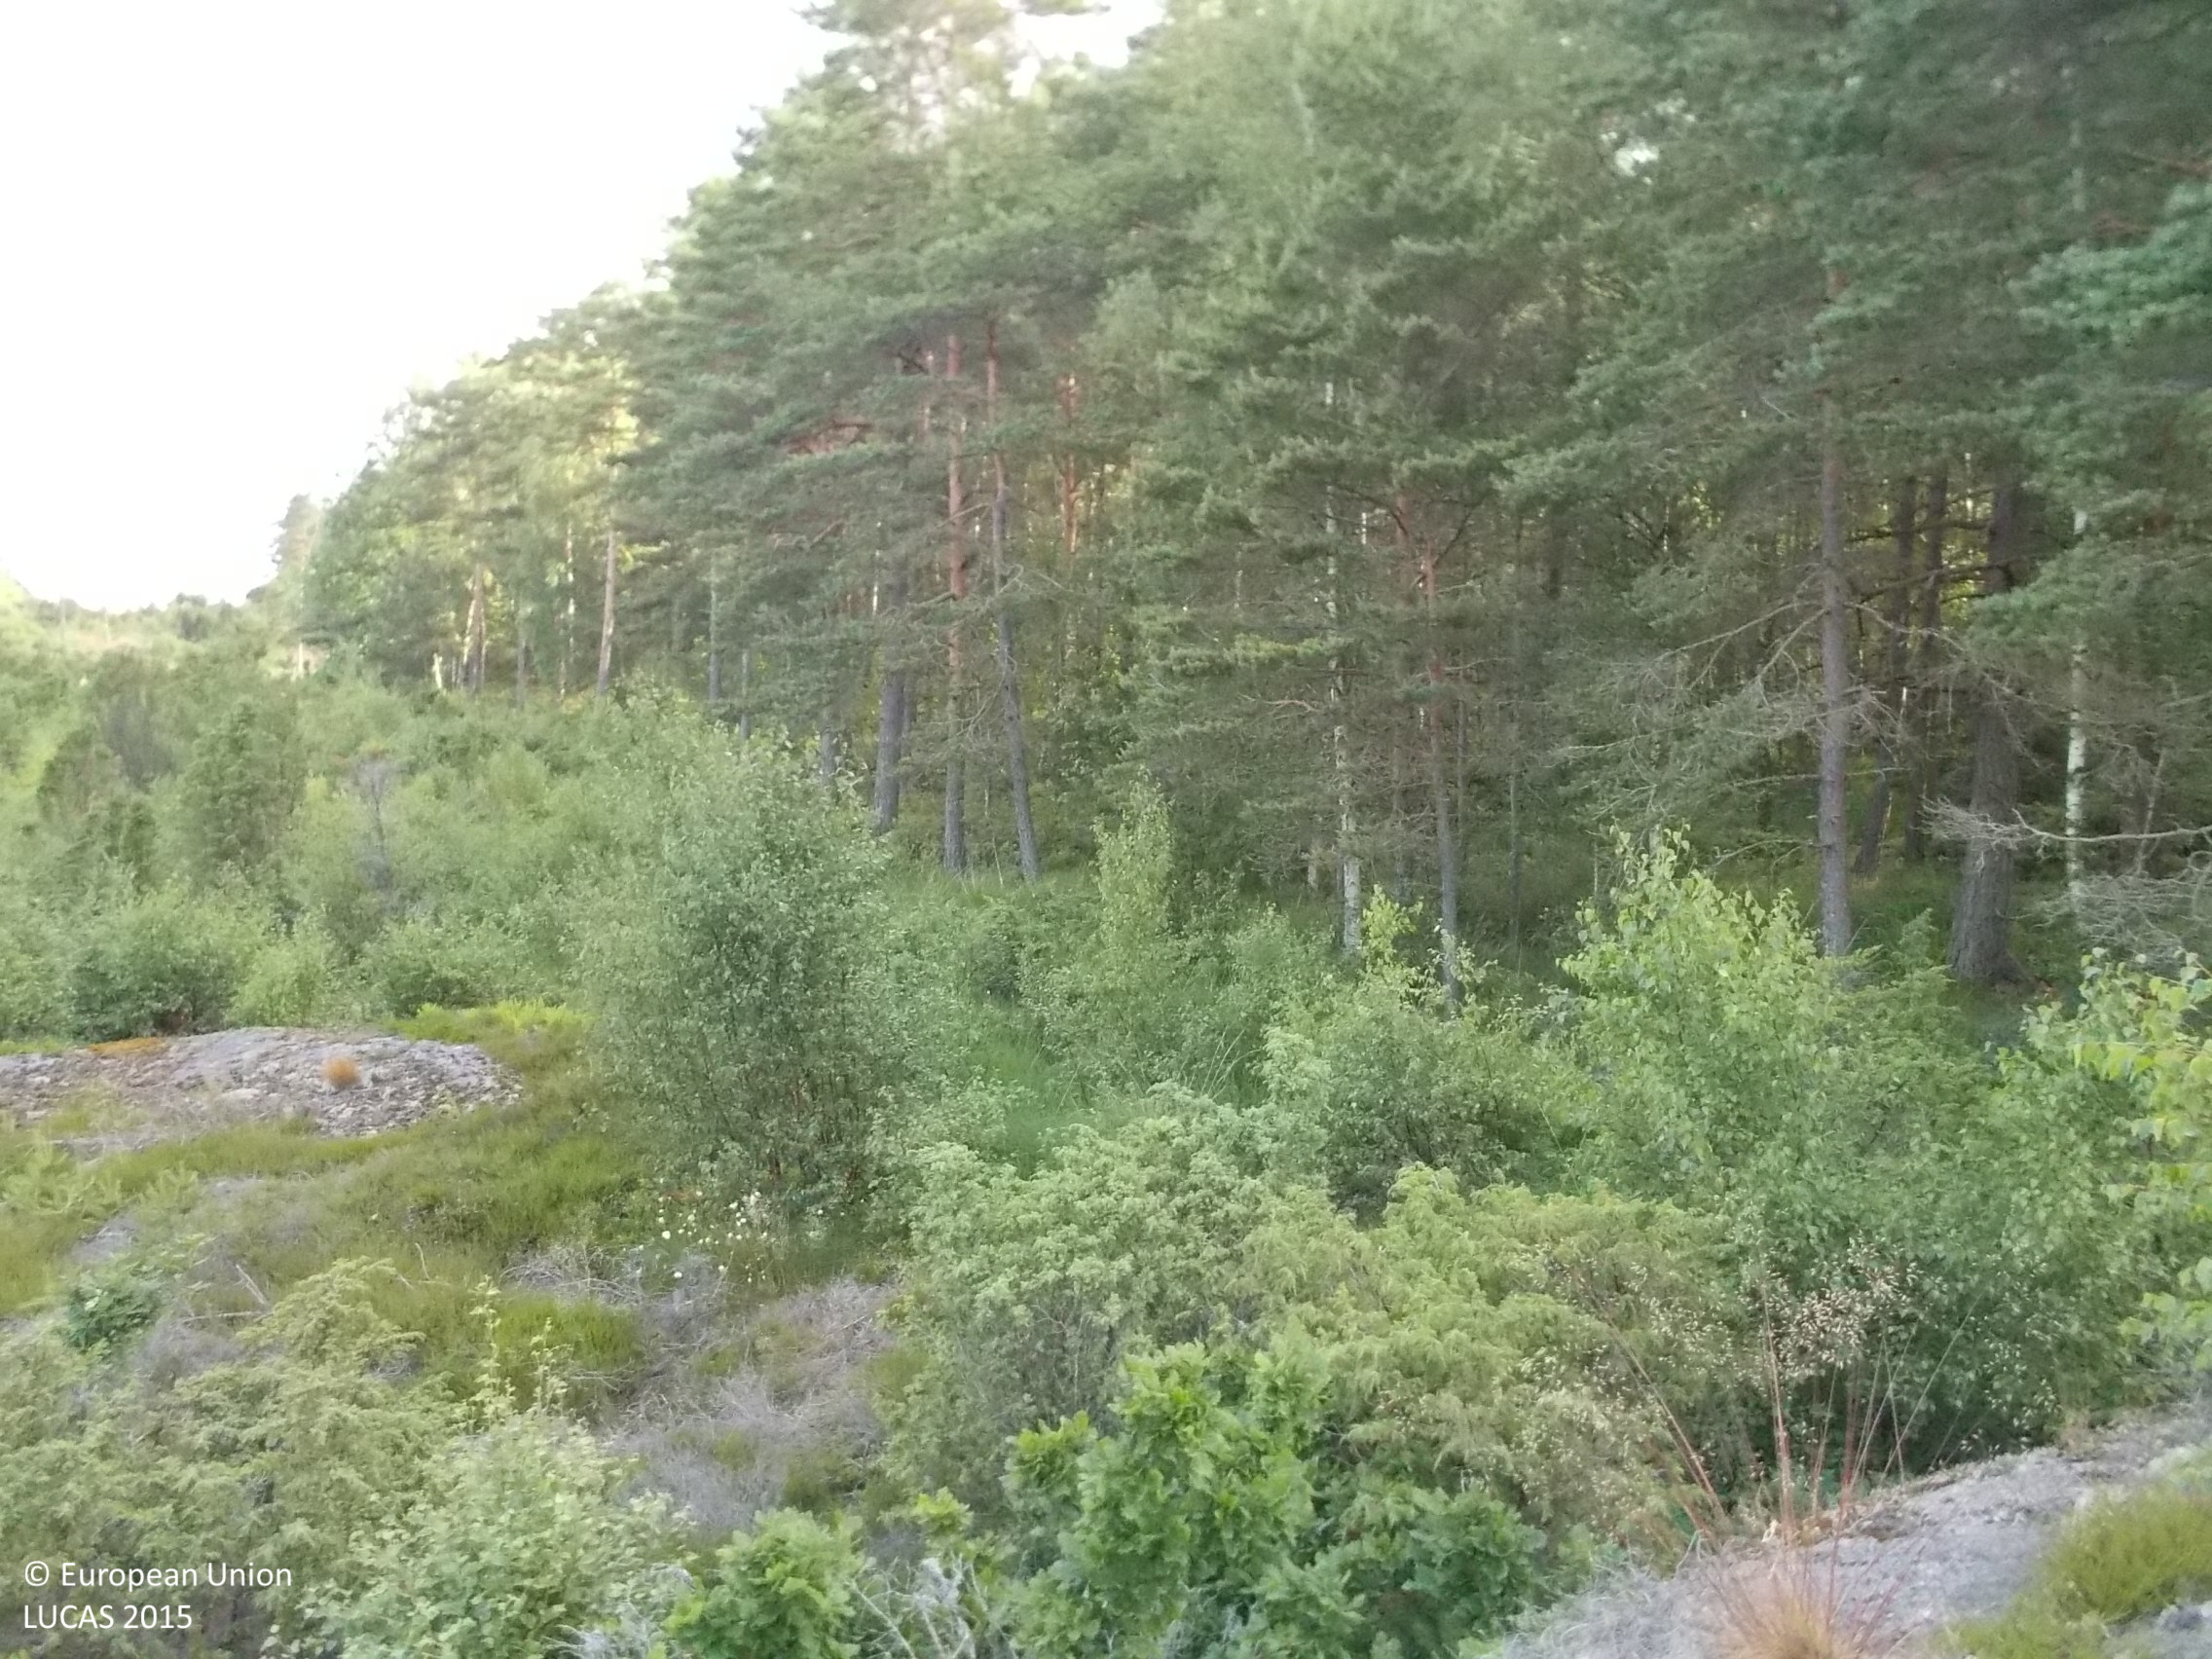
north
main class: Shrubland
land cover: Shrubland with sparse tree cover
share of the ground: > 75 %
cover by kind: shrubs 70 %, herbaceous plants 10 %, lichens and mosses 10 %, broadleaved forest trees 5 %, consolidated bare surface 5 %
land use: Electricity, gas and thermal power distribution
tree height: < 5 m
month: July
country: SE
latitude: 57.1930
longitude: 12.2639
